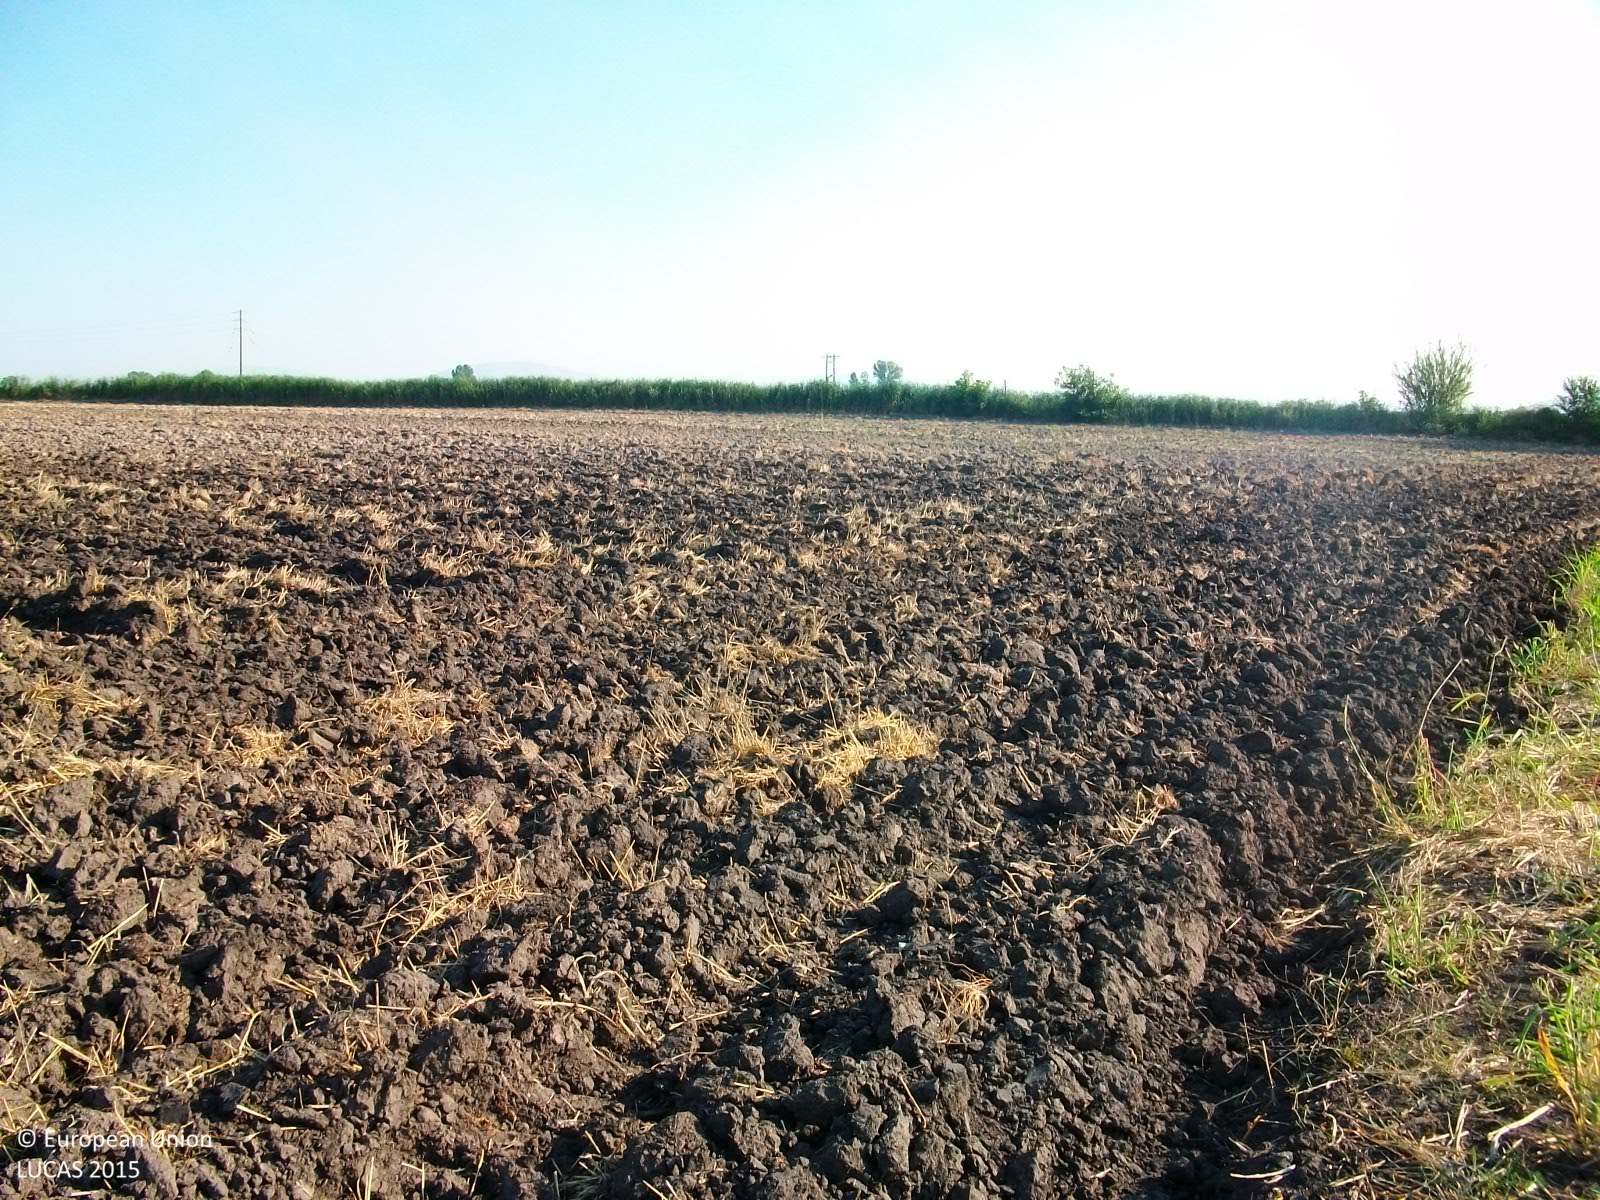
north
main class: Grassland
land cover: Spontaneously vegetated surfaces
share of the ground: > 75 %
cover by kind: herbaceous plants 100 %
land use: Fallow land
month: July
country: GR
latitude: 39.2551
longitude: 22.2792
